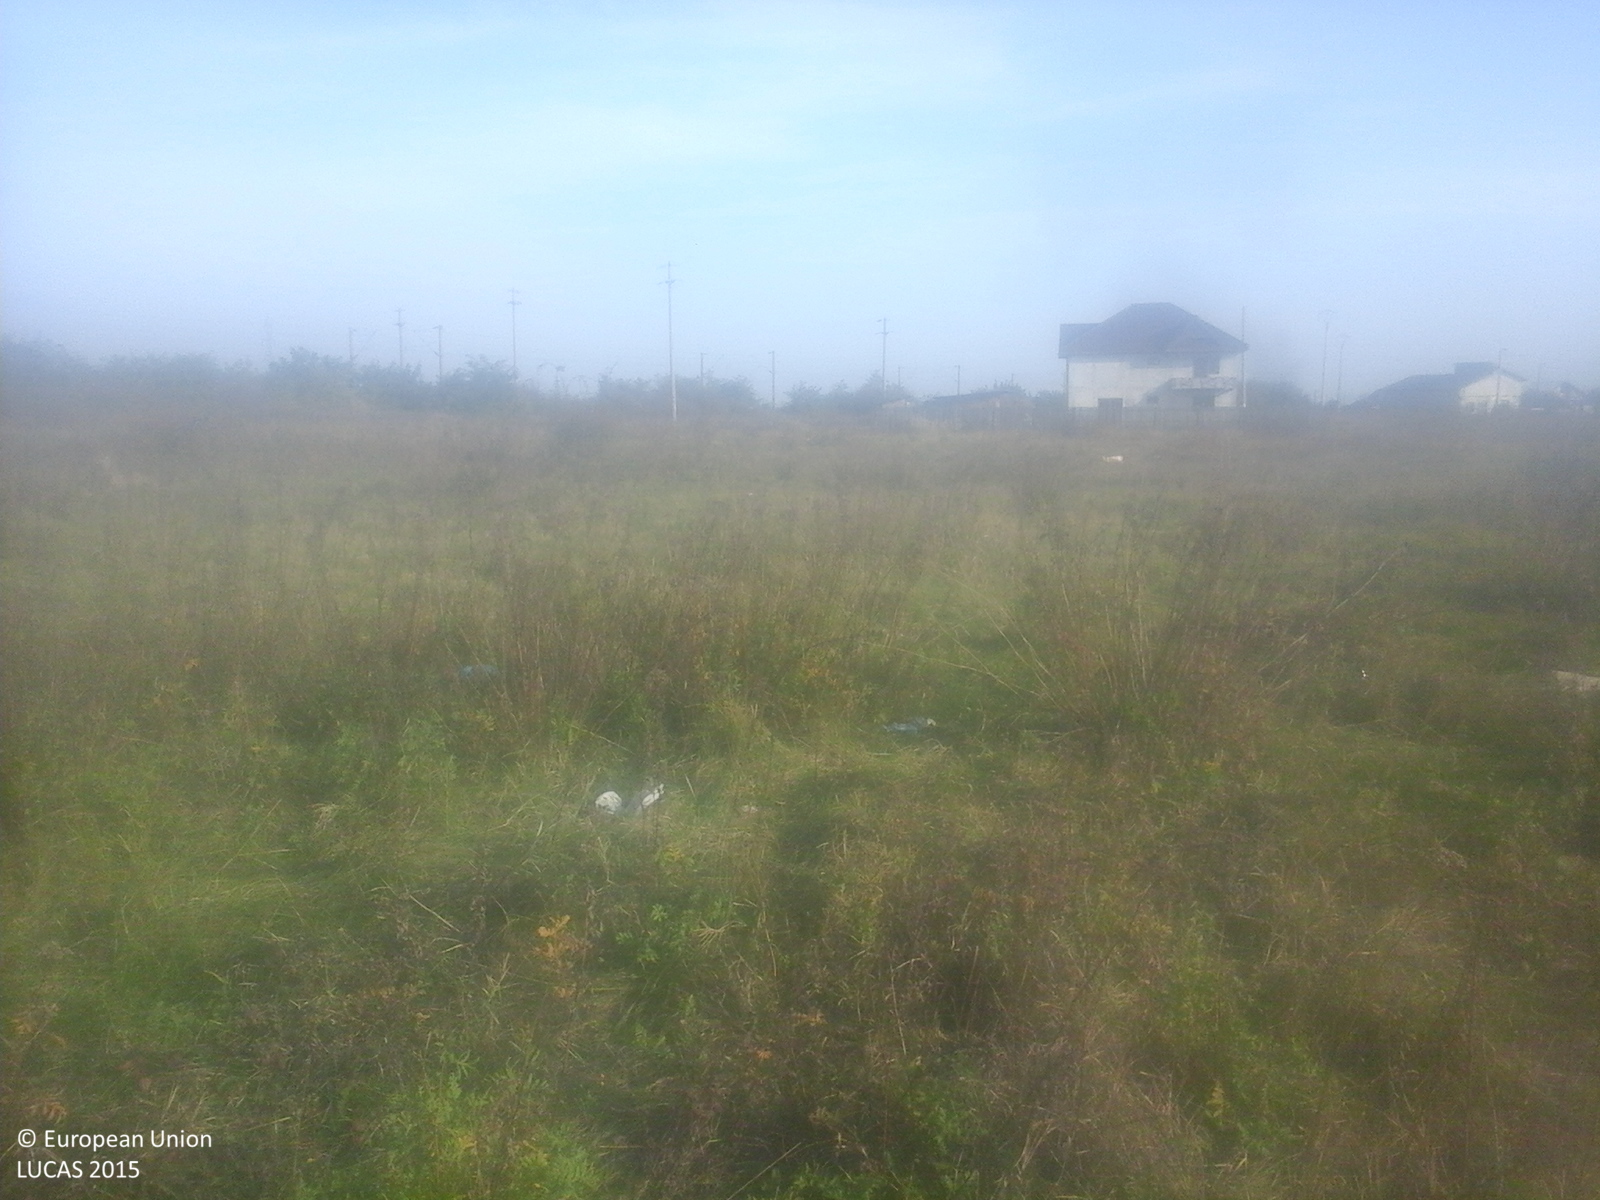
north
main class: Grassland
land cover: Grassland with sparse tree/shrub cover
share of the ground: > 75 %
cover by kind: herbaceous plants 85 %, shrubs 10 %, broadleaved forest trees 5 %
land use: Agriculture (excluding fallow land and kitchen gardens)
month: October
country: RO
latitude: 45.3901
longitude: 27.0638
